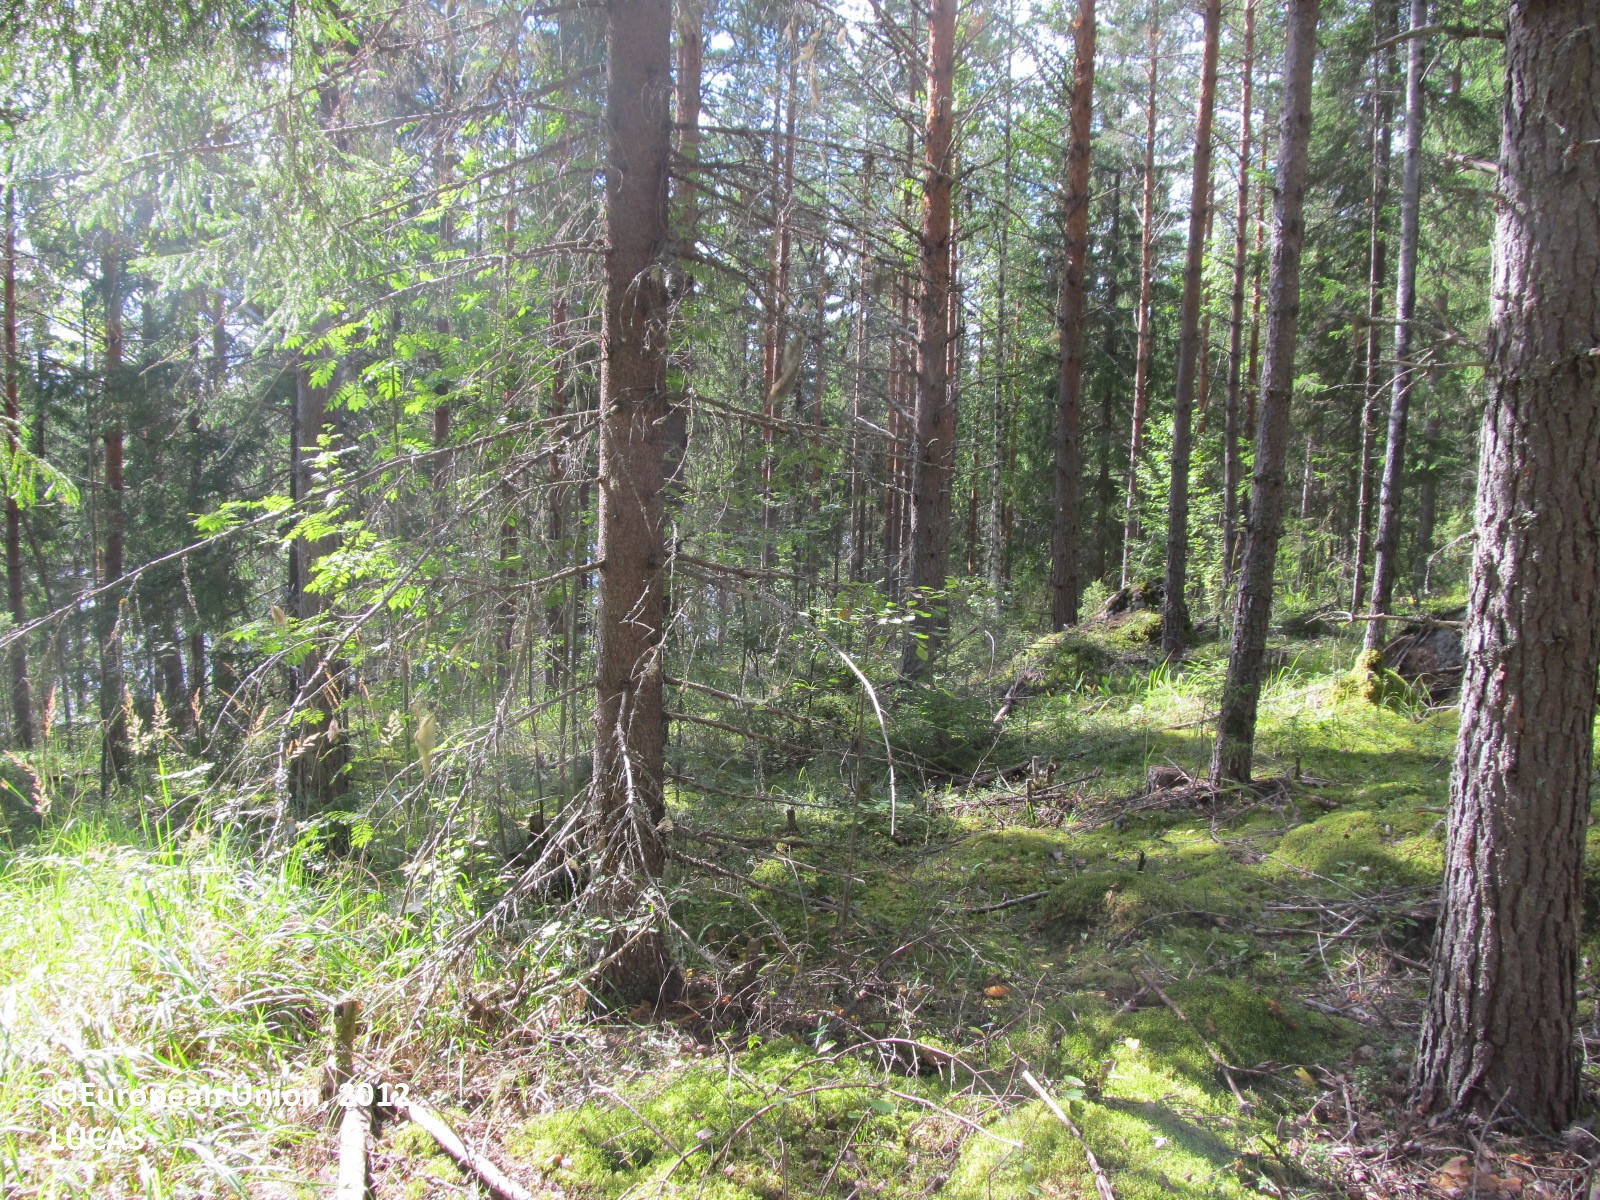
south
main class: Woodland
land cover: Other coniferous woodland
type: boreal forest
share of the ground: 25 - 50 %
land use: Forestry
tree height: > 5 m
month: August
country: FI
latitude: 61.6762
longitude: 27.4233
